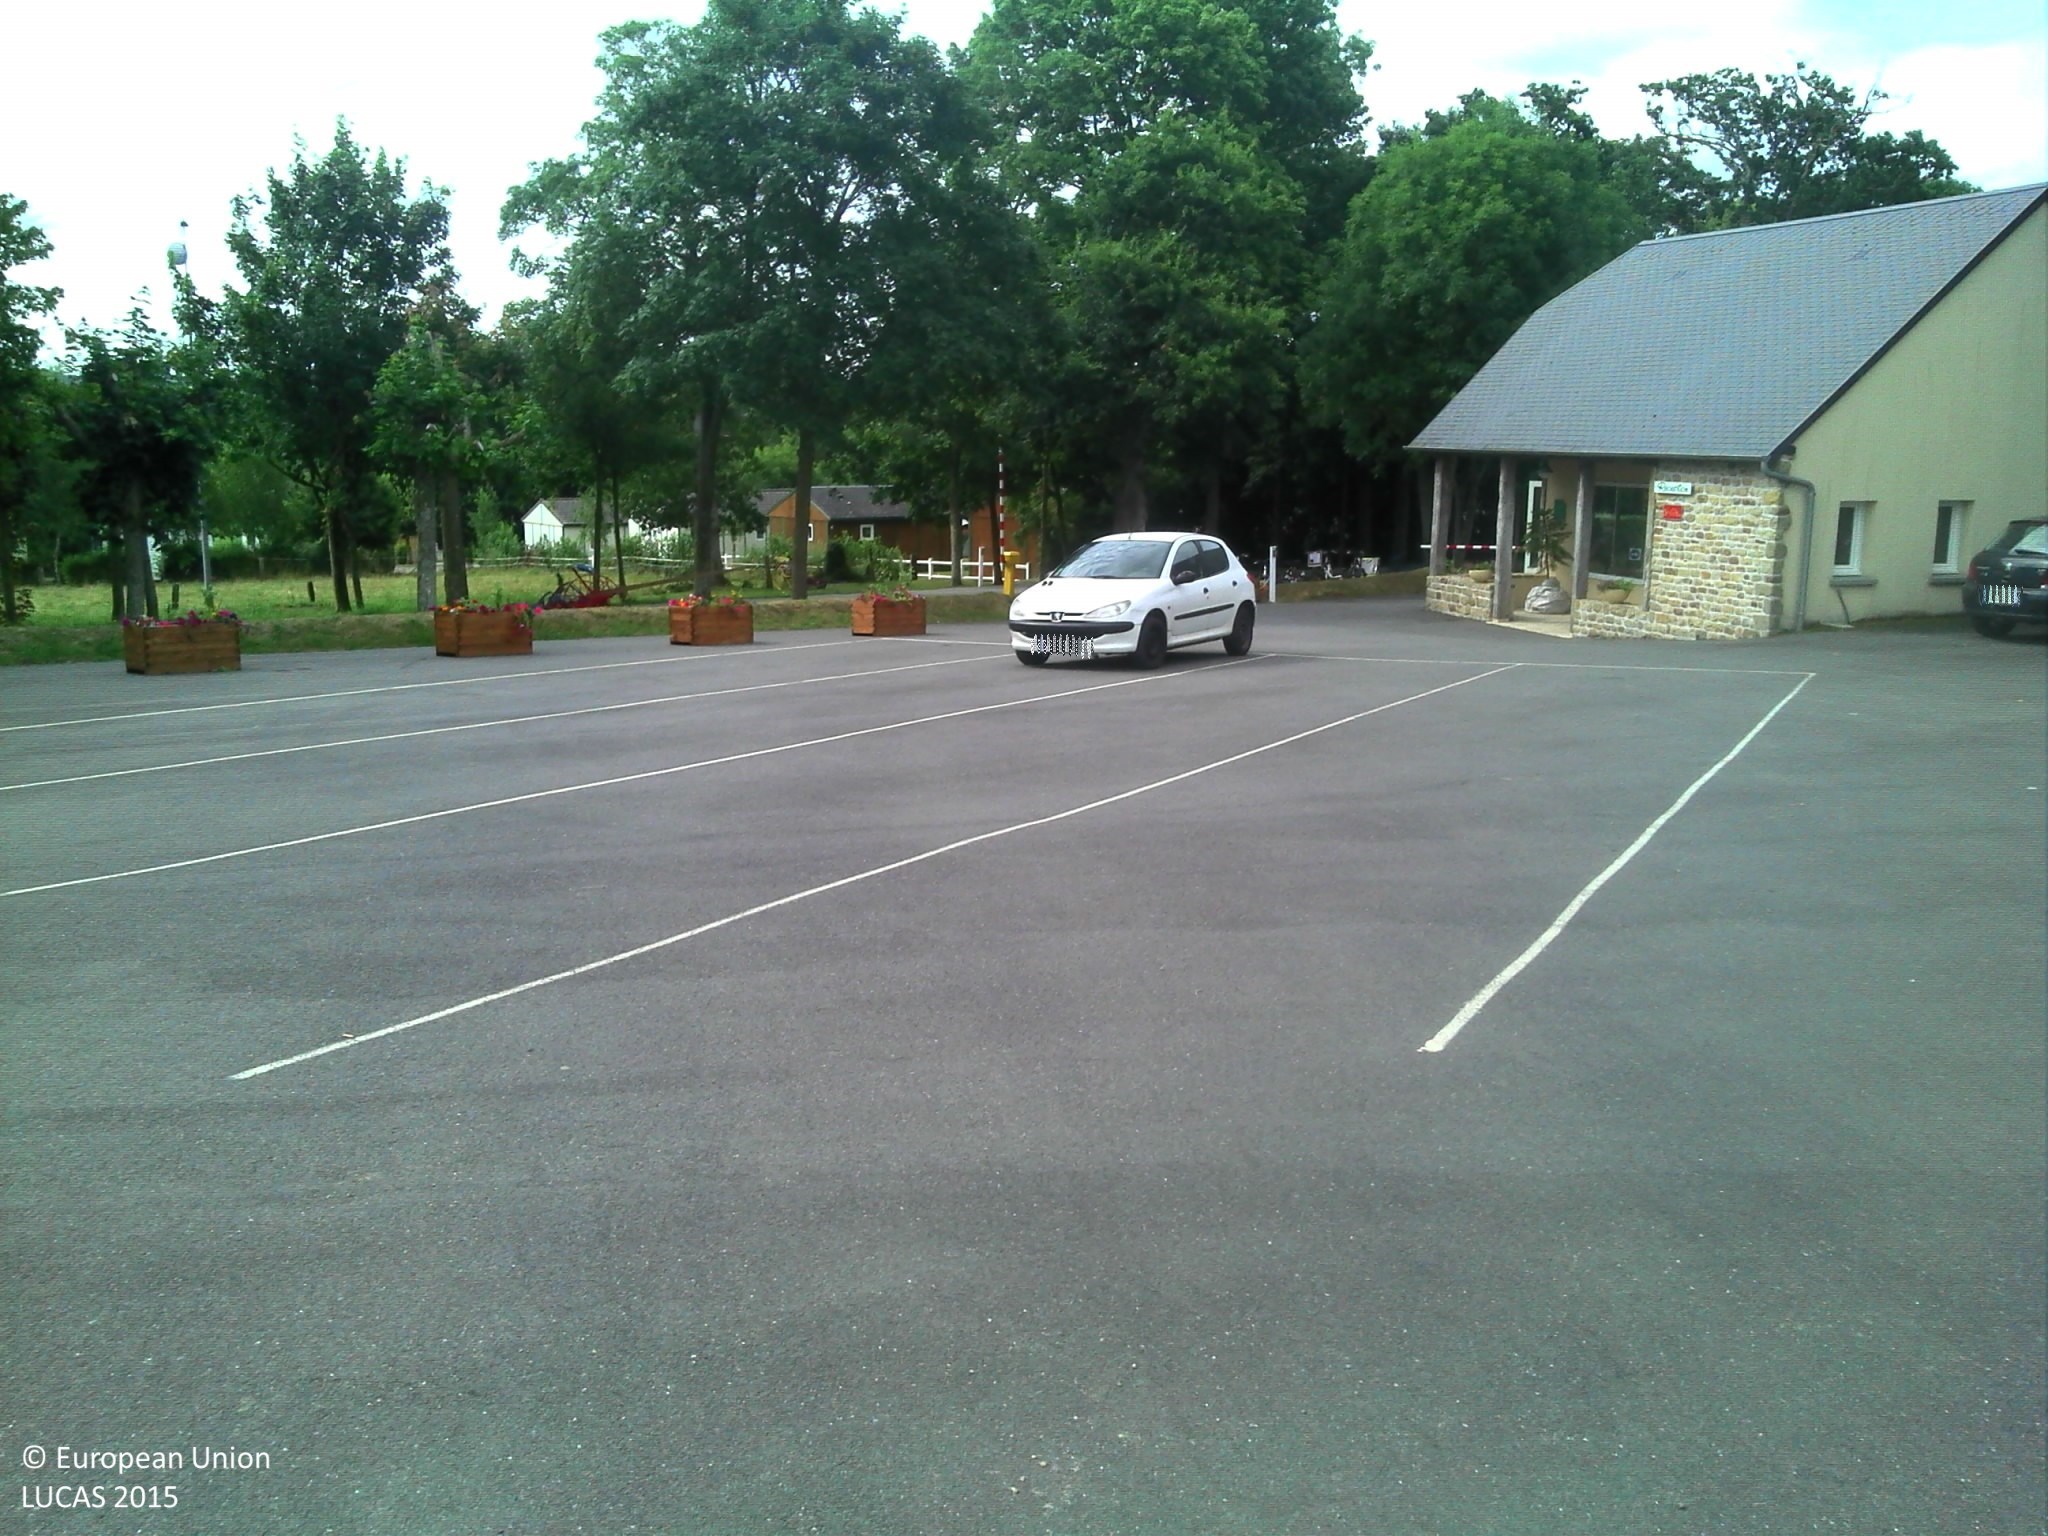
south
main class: Grassland
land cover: Grassland without tree/shrub cover
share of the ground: > 75 %
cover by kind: herbaceous plants 100 %
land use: Semi-natural and natural areas not in use
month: July
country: FR
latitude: 48.7981
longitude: -1.5247
